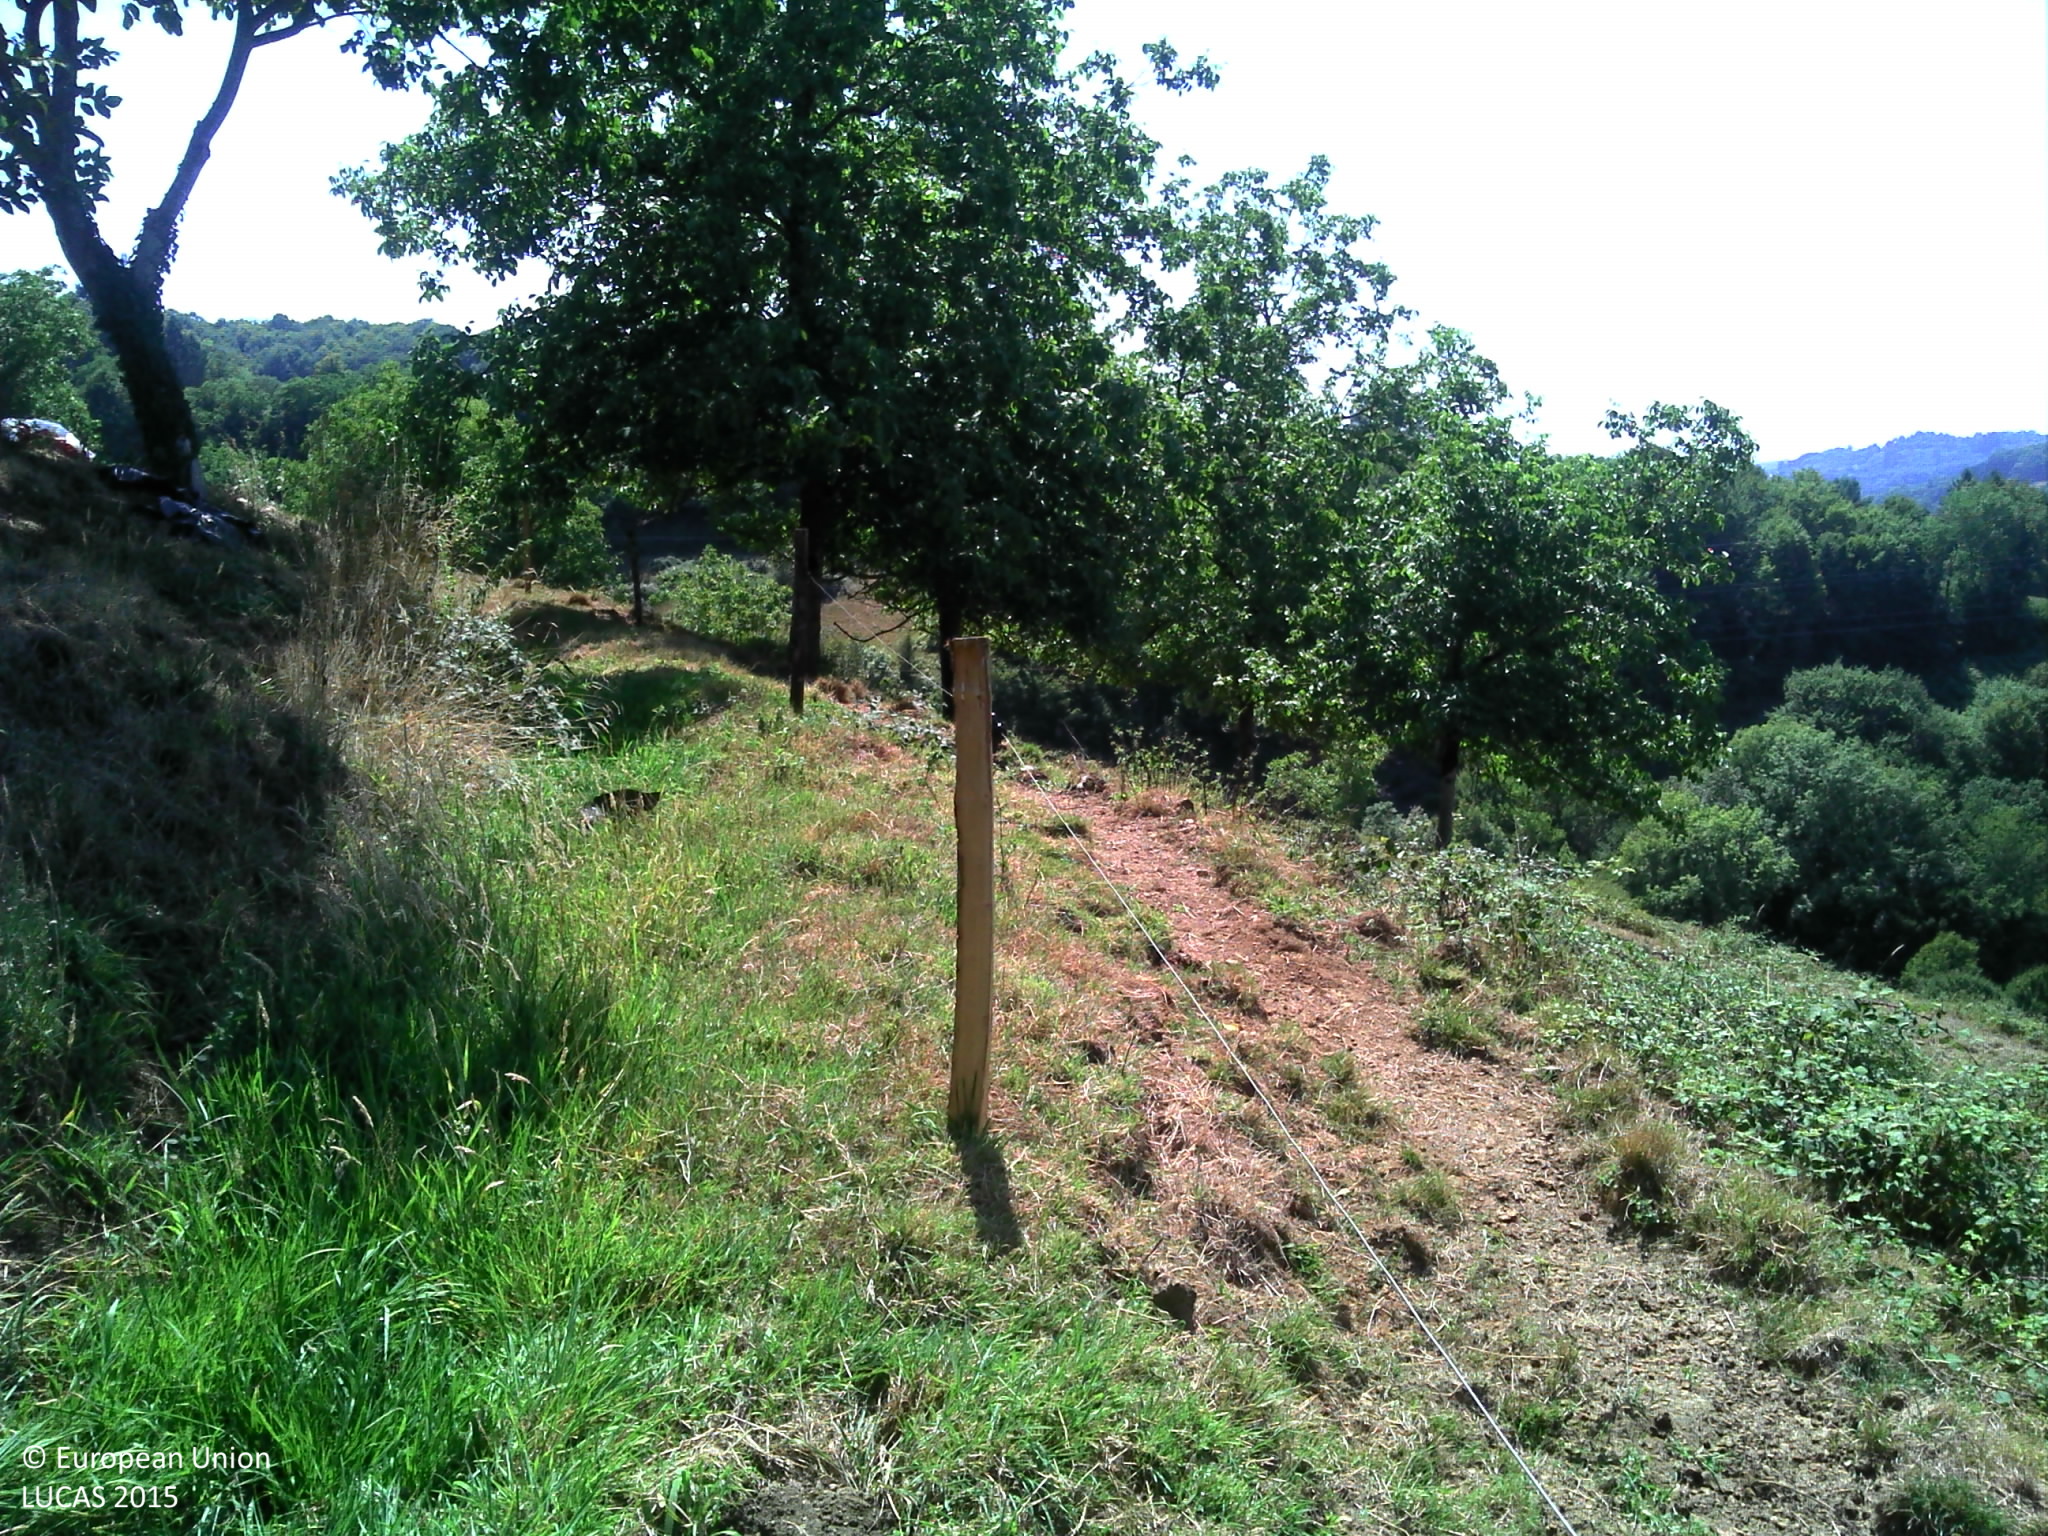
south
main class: Grassland
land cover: Grassland without tree/shrub cover
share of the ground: > 75 %
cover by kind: herbaceous plants 95 %, shrubs 5 %
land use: Agriculture (excluding fallow land and kitchen gardens)
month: August
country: FR
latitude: 45.2935
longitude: 1.7971
